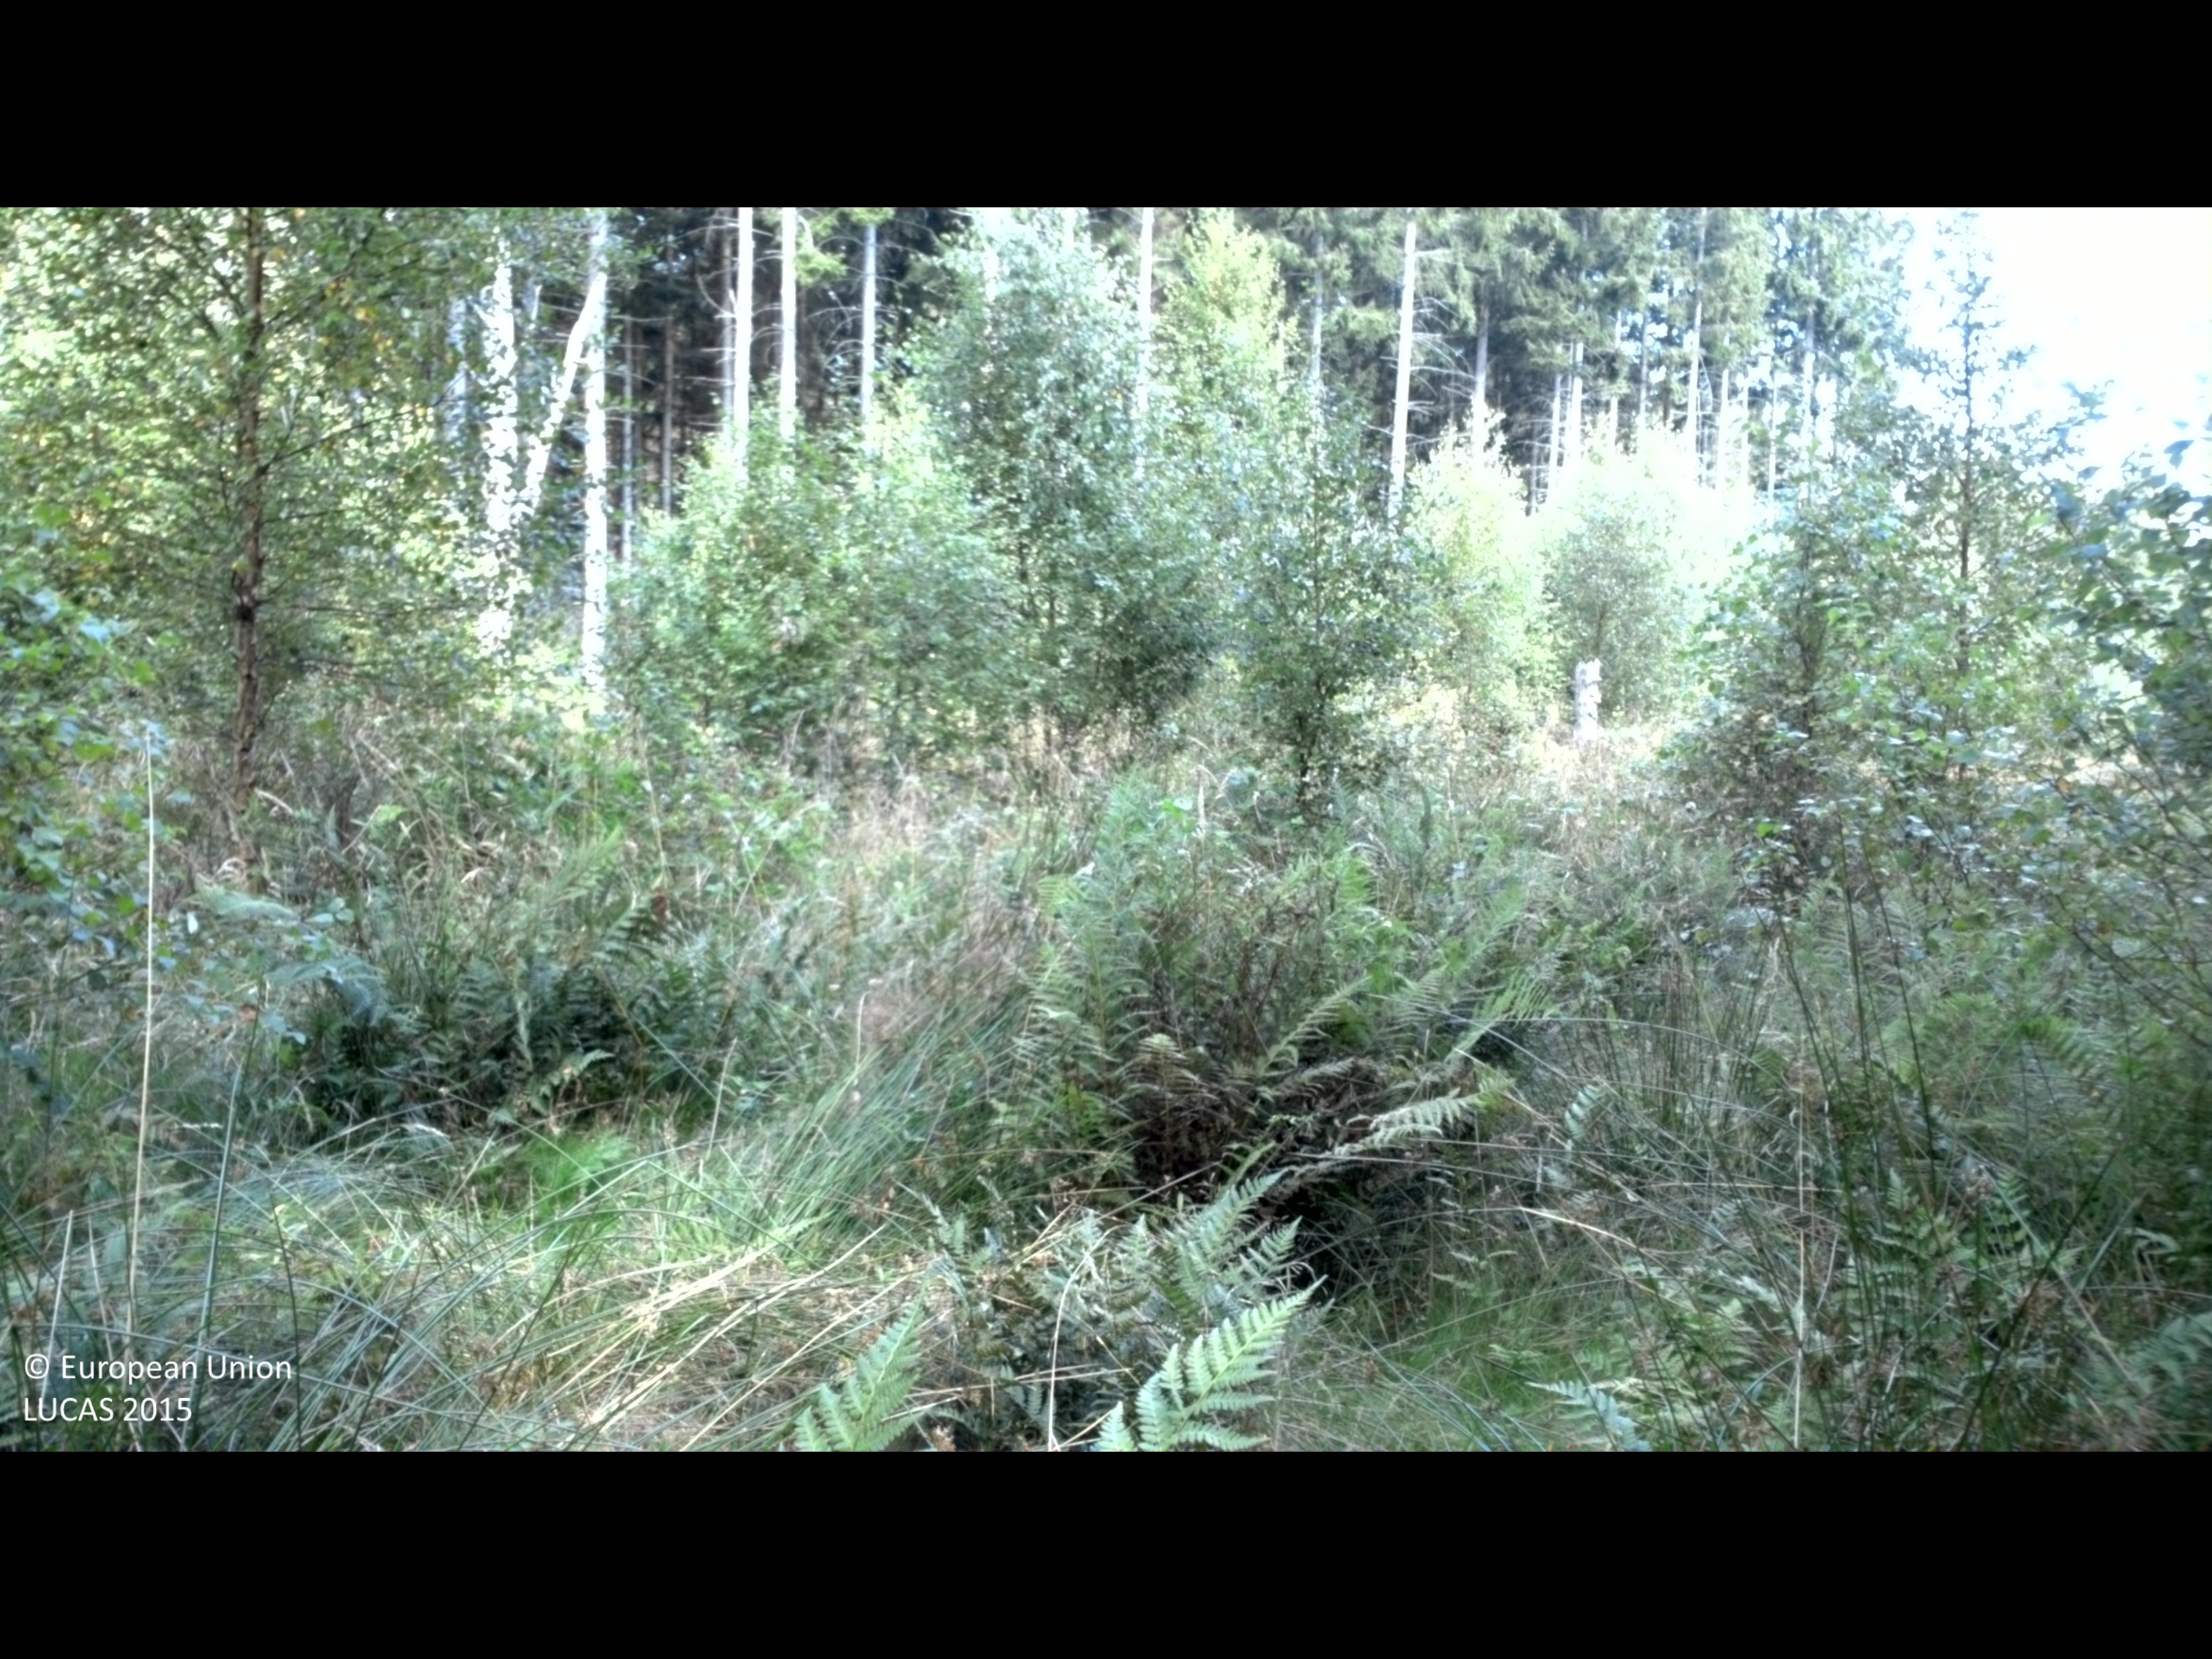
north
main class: Woodland
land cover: Spruce dominated mixed woodland
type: boreal forest
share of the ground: 50 - 75 %
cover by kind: coniferous forest trees 40 %, herbaceous plants 35 %, broadleaved forest trees 20 %, shrubs 5 %
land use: Forestry
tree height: > 5 m
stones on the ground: < 10 %
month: August
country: SE
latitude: 56.2888
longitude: 14.5053
